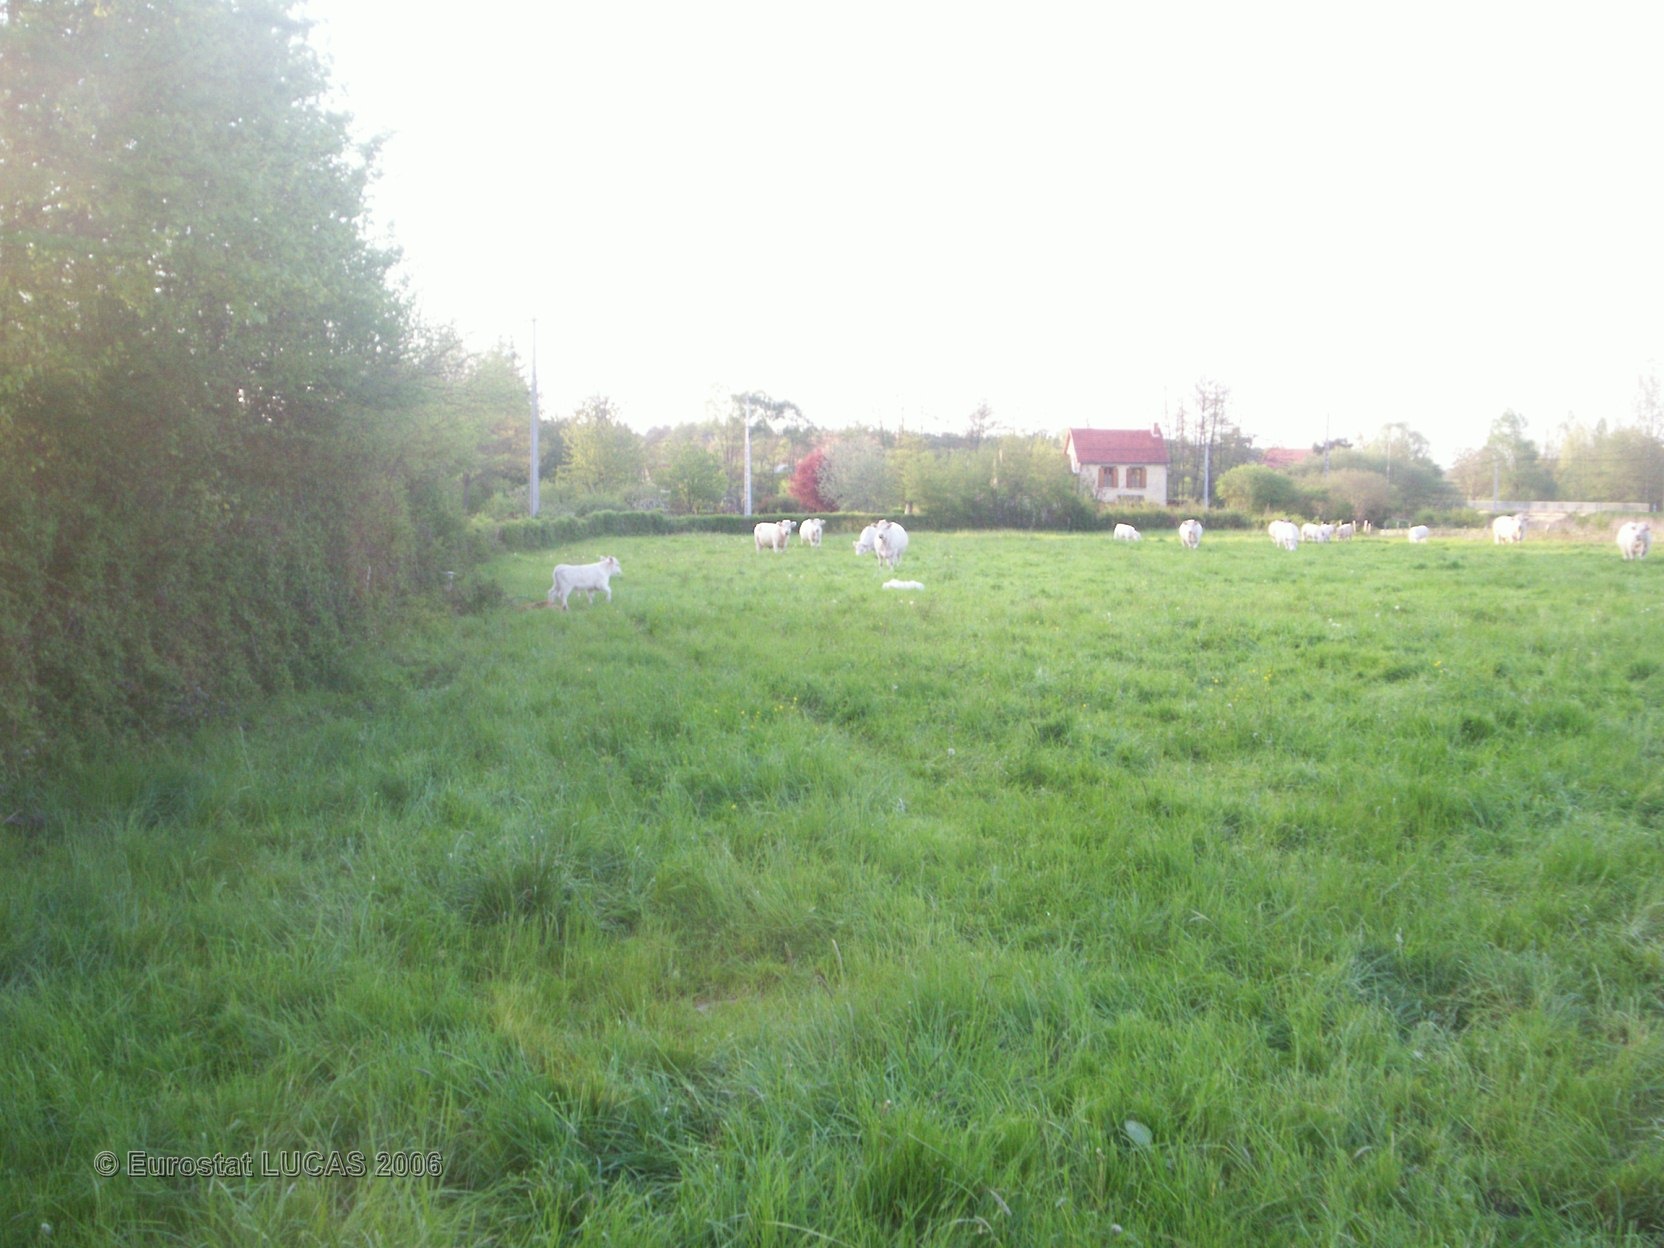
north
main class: Grassland
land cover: Grassland without tree/shrub cover
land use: Agriculture (excluding fallow land and kitchen gardens)
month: May
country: FR
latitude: 46.2375
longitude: 3.1123
